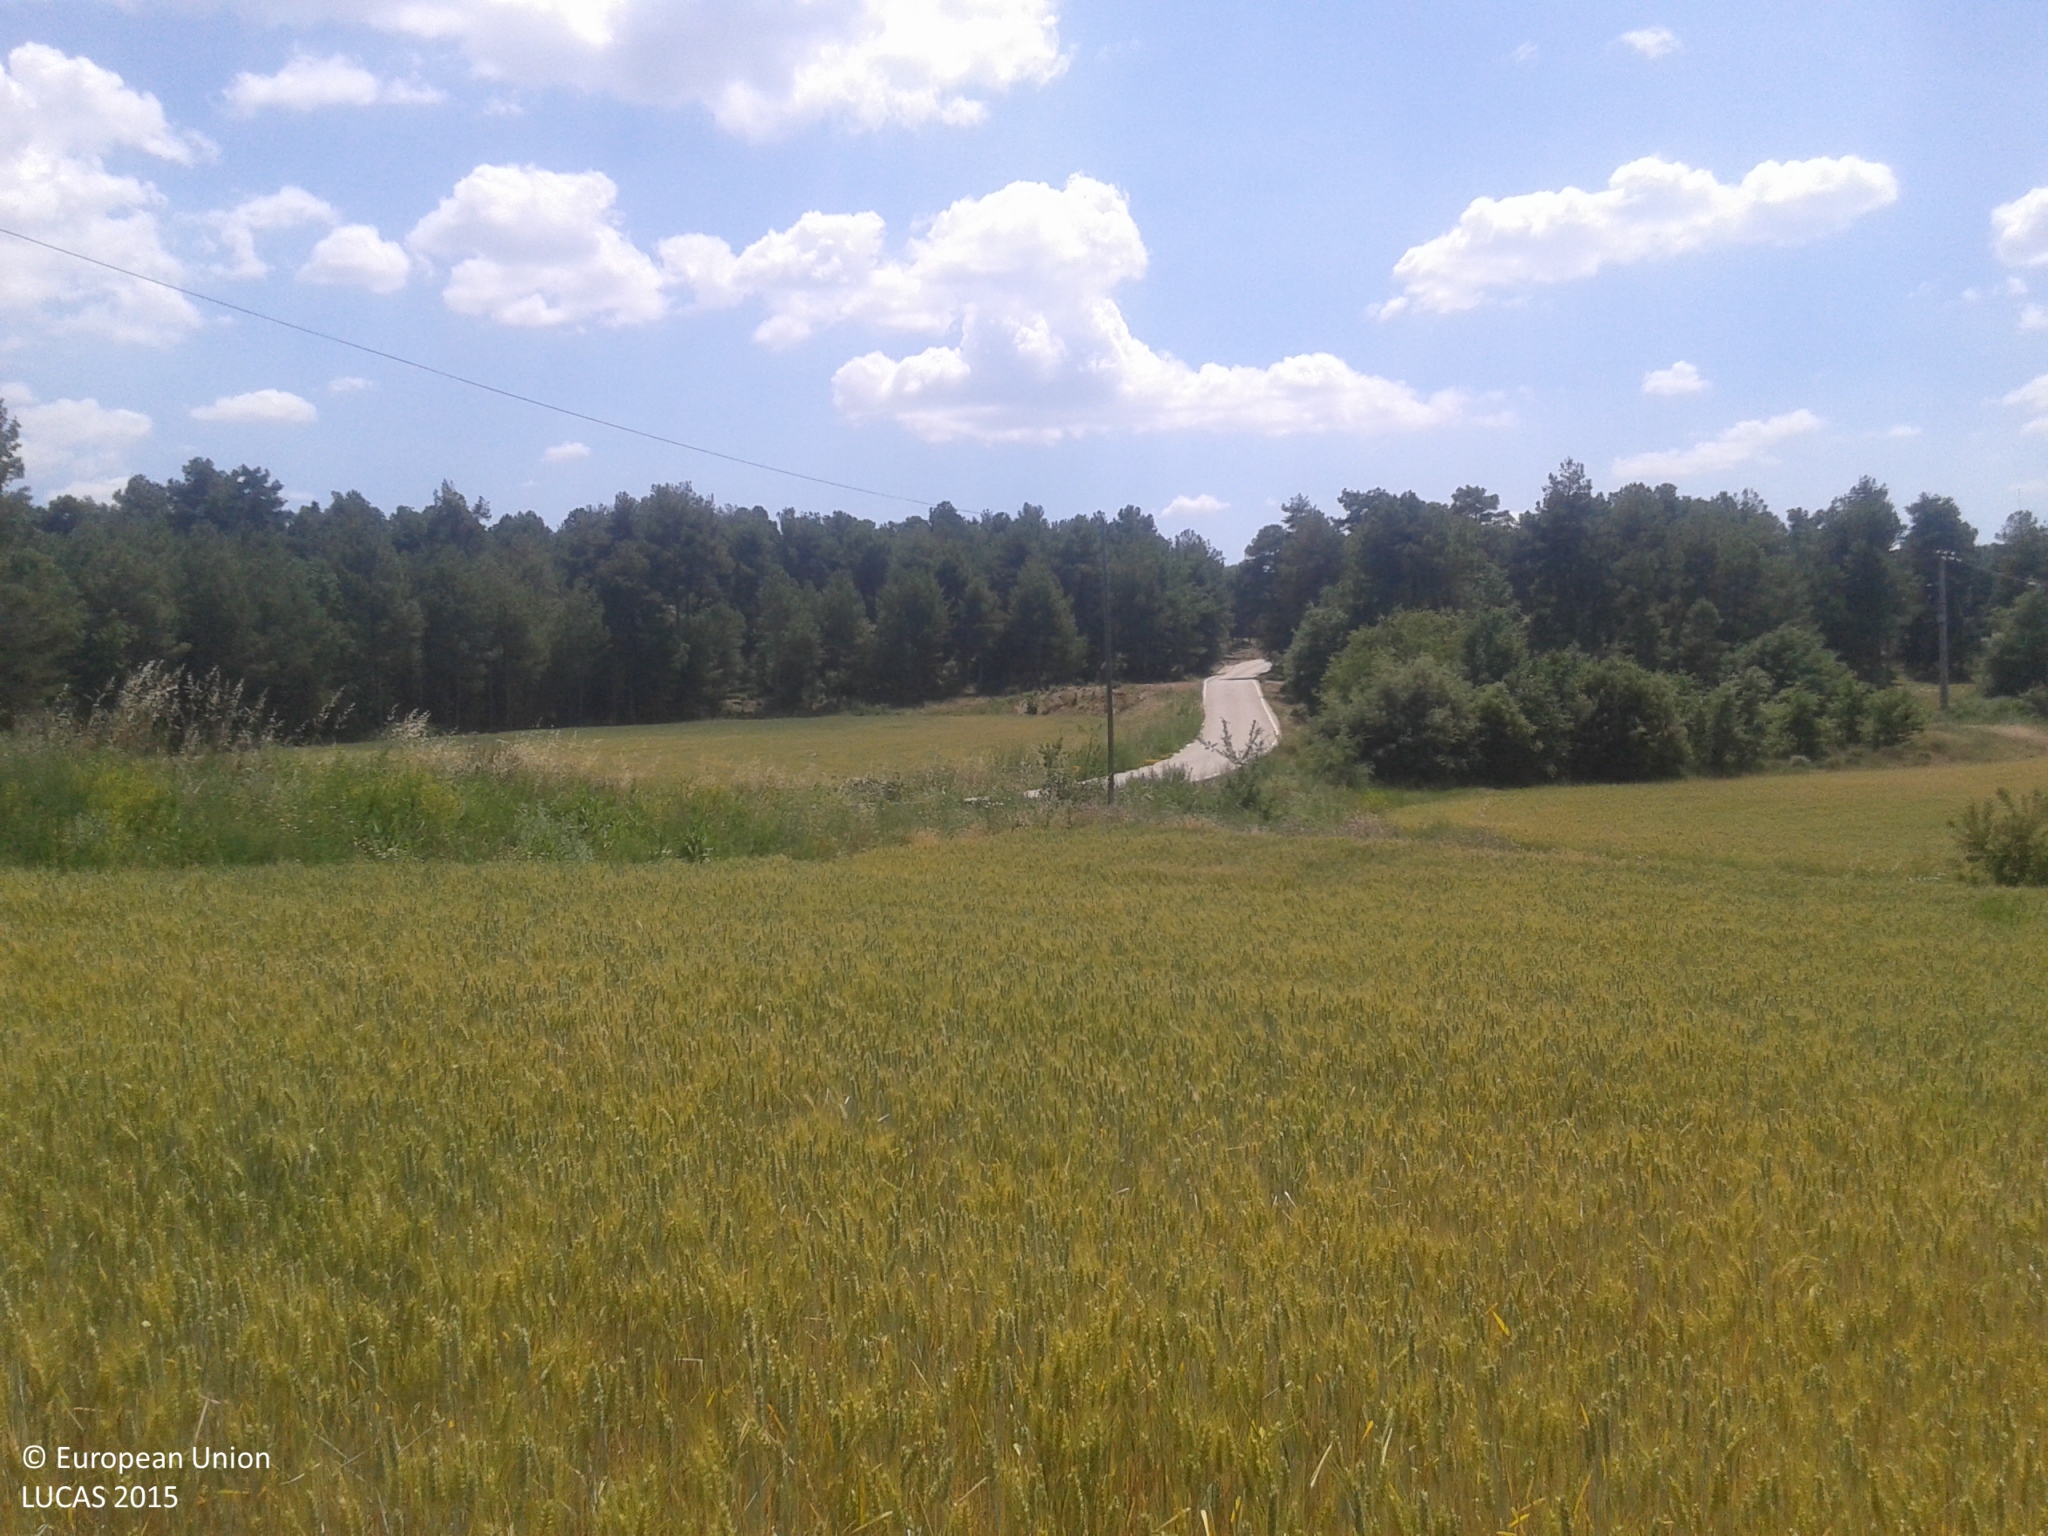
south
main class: Cropland
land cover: Common wheat
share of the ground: > 75 %
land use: Agriculture (excluding fallow land and kitchen gardens)
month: June
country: ES
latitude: 41.9739
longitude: 1.5532
